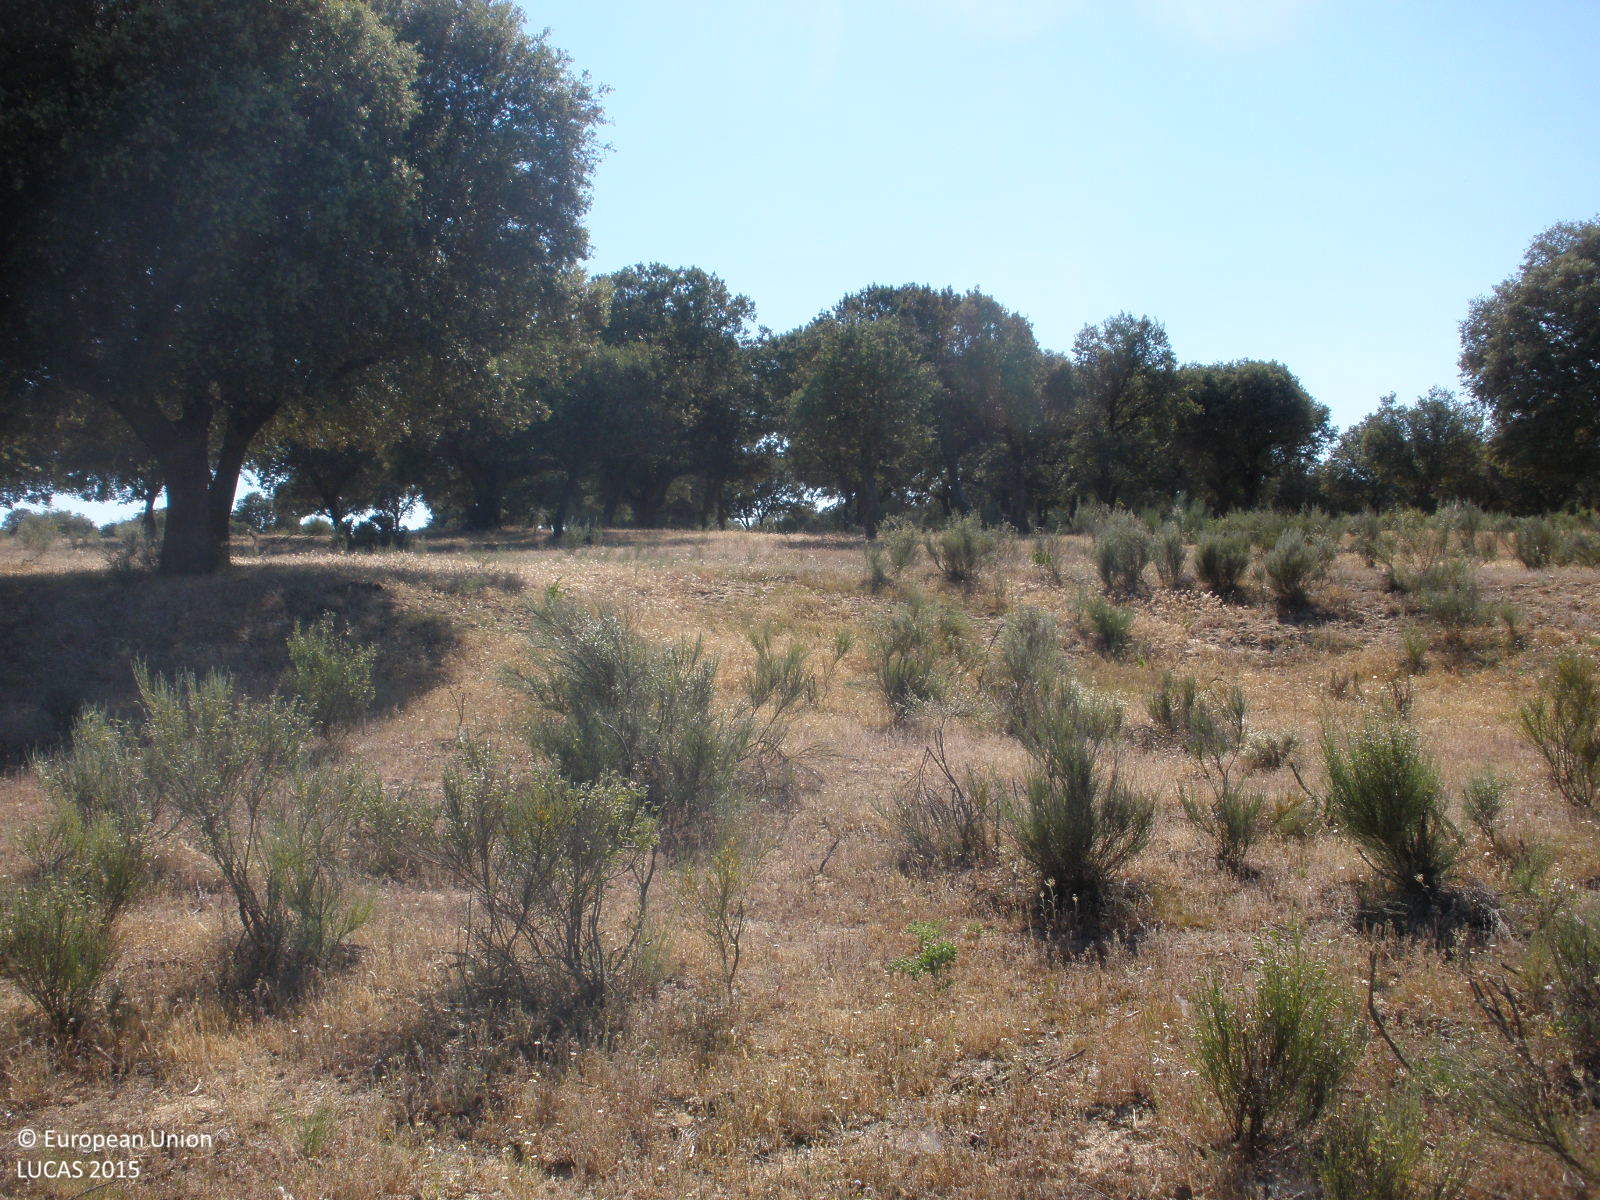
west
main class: Shrubland
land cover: Shrubland with sparse tree cover
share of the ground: 50 - 75 %
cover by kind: shrubs 50 %, herbaceous plants 35 %, consolidated bare surface 10 %, broadleaved forest trees 5 %
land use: Agriculture (excluding fallow land and kitchen gardens)
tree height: < 5 m
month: June
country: ES
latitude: 40.5021
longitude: -6.6947
